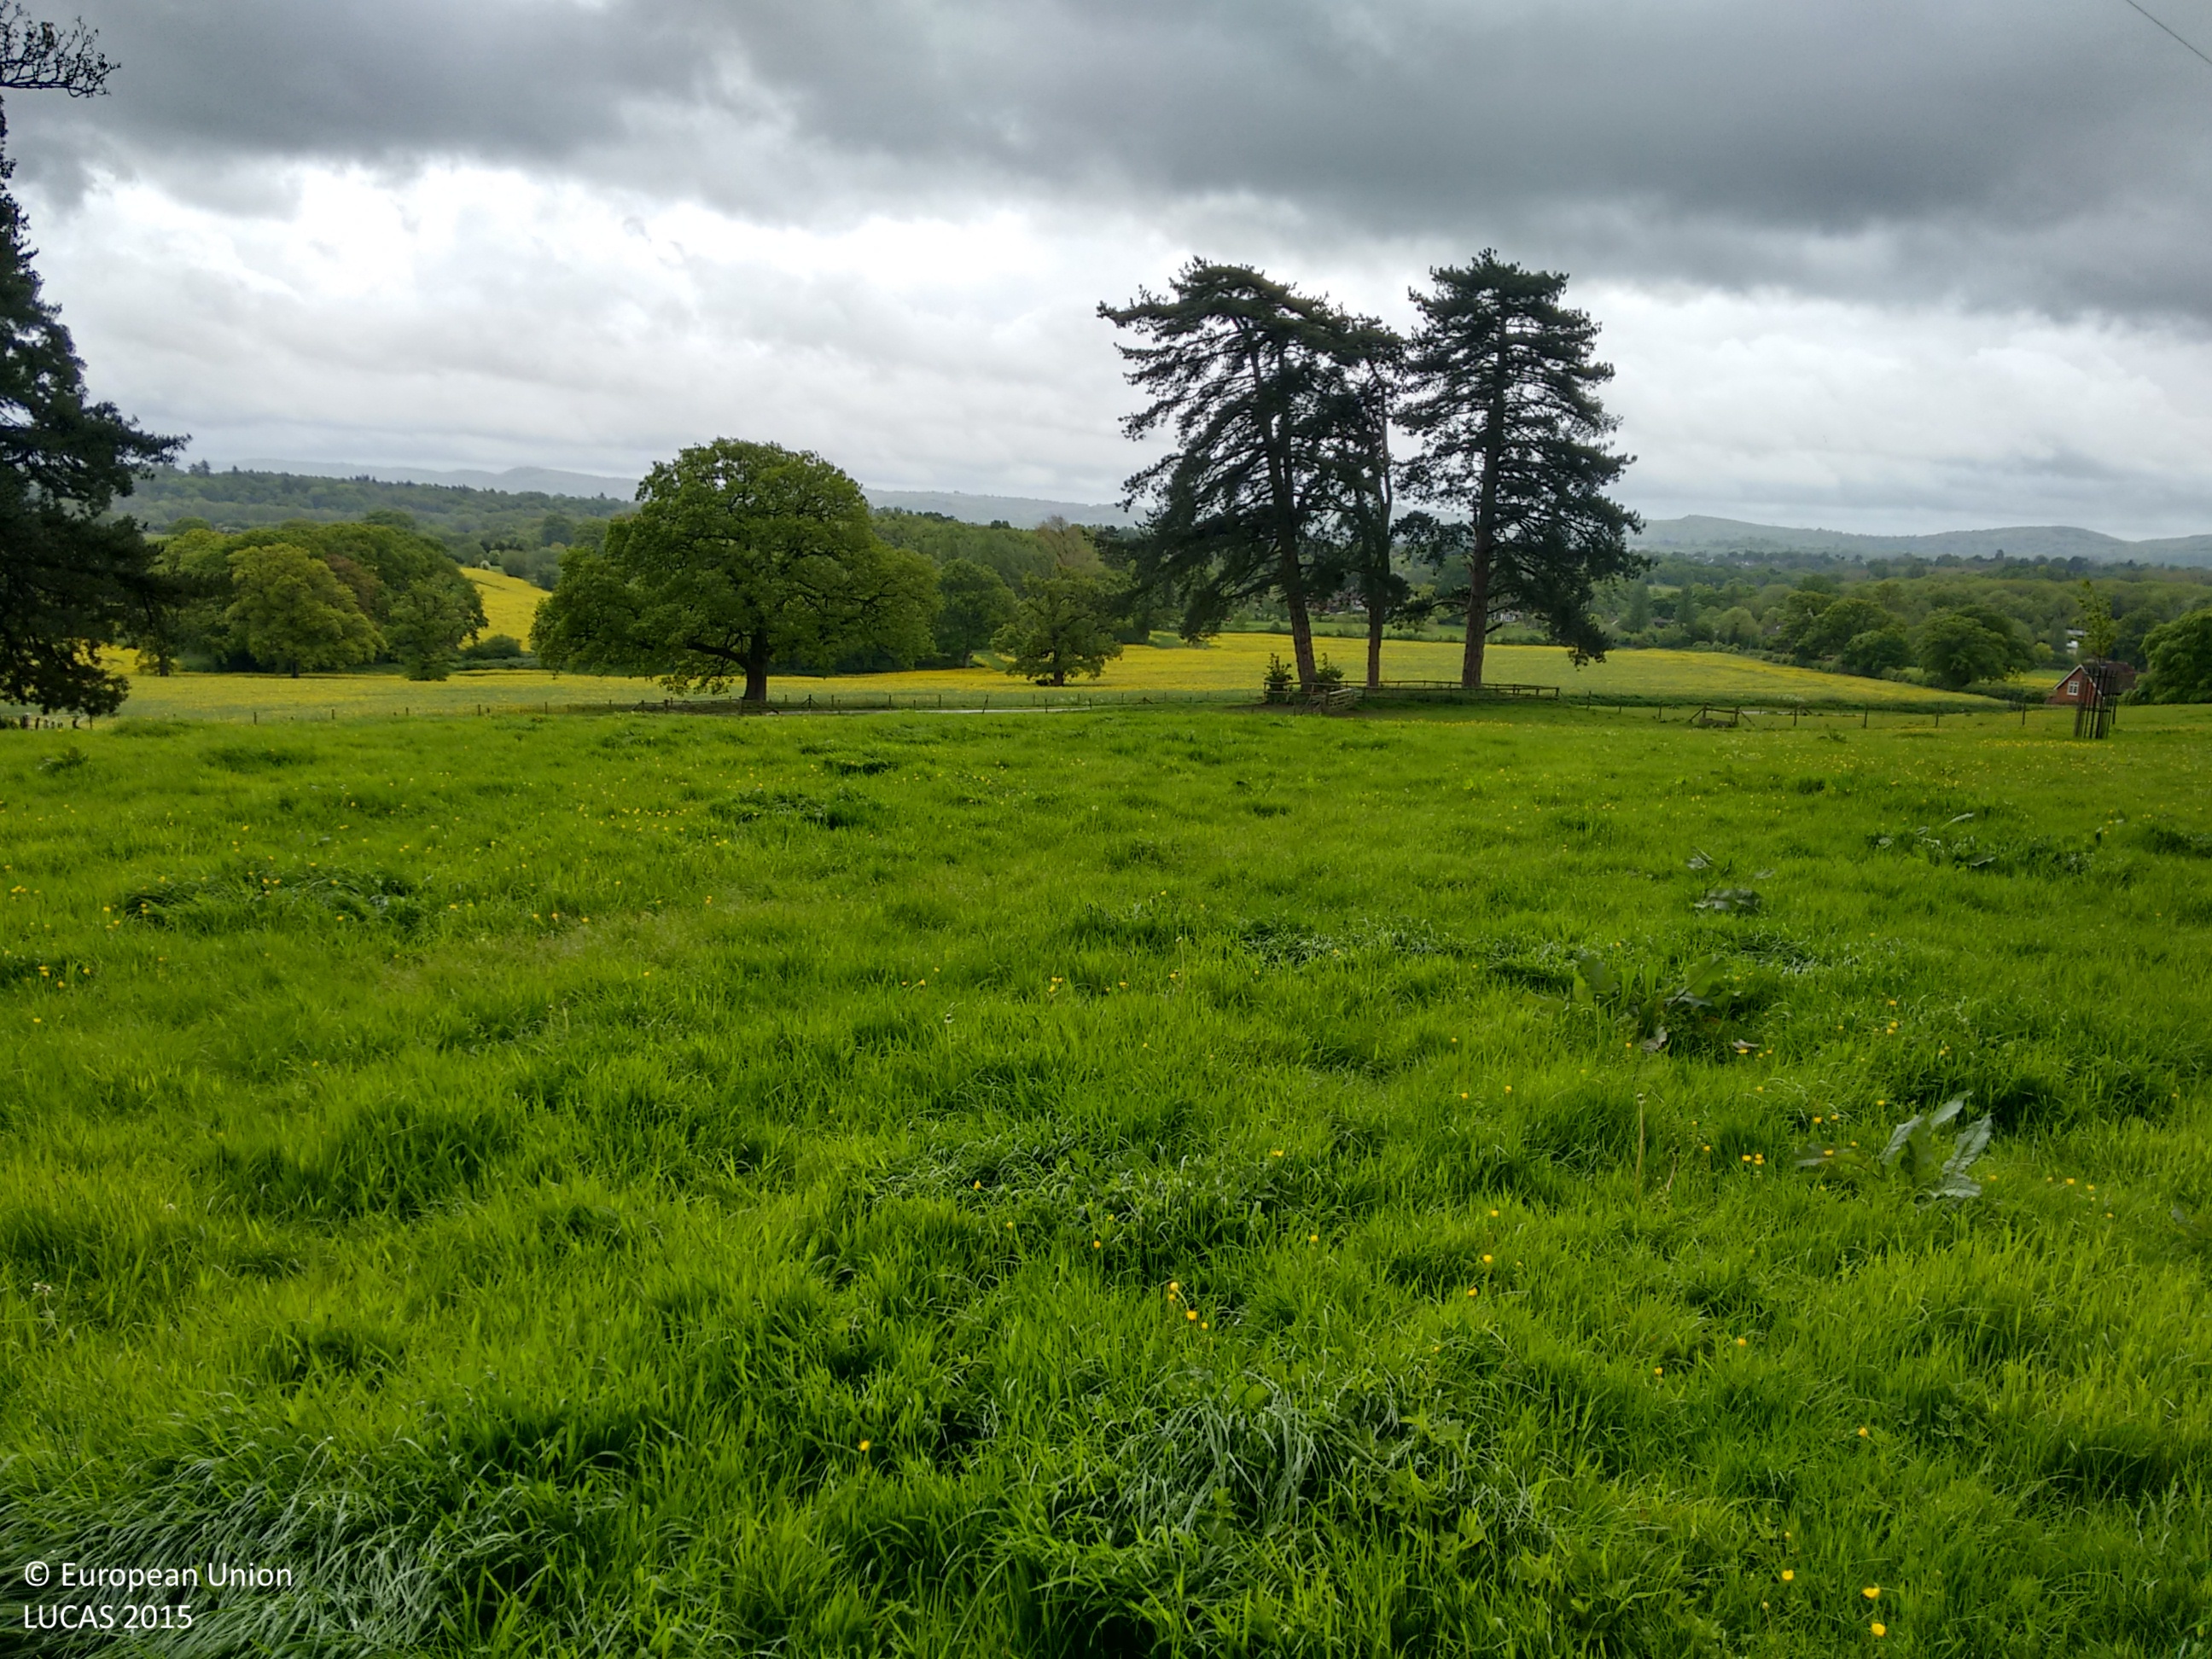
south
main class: Grassland
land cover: Grassland without tree/shrub cover
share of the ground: > 75 %
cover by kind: herbaceous plants 100 %
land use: Agriculture (excluding fallow land and kitchen gardens)
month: May
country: GB
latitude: 51.0368
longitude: -0.9246
